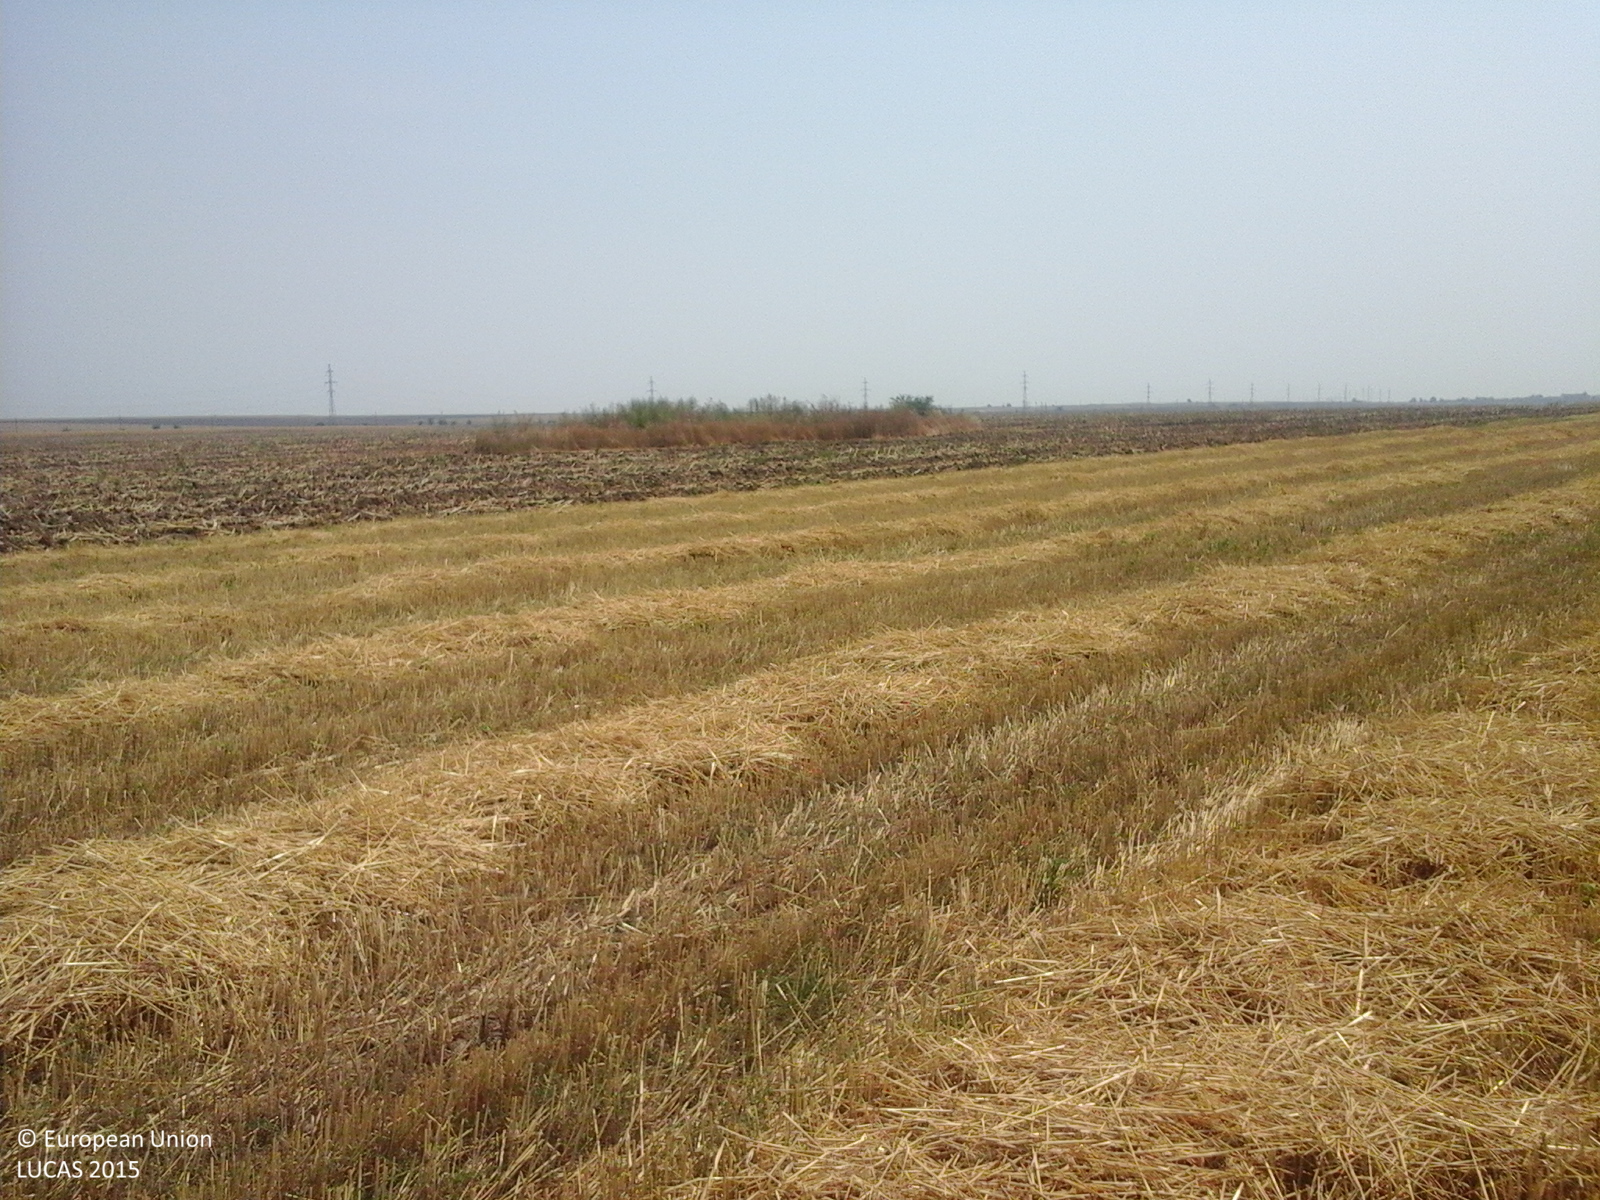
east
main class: Cropland
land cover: Common wheat
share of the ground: > 75 %
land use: Agriculture (excluding fallow land and kitchen gardens)
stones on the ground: < 10 %
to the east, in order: Common wheat; Rape and turnip rape
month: August
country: RO
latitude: 44.2356
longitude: 22.7481
